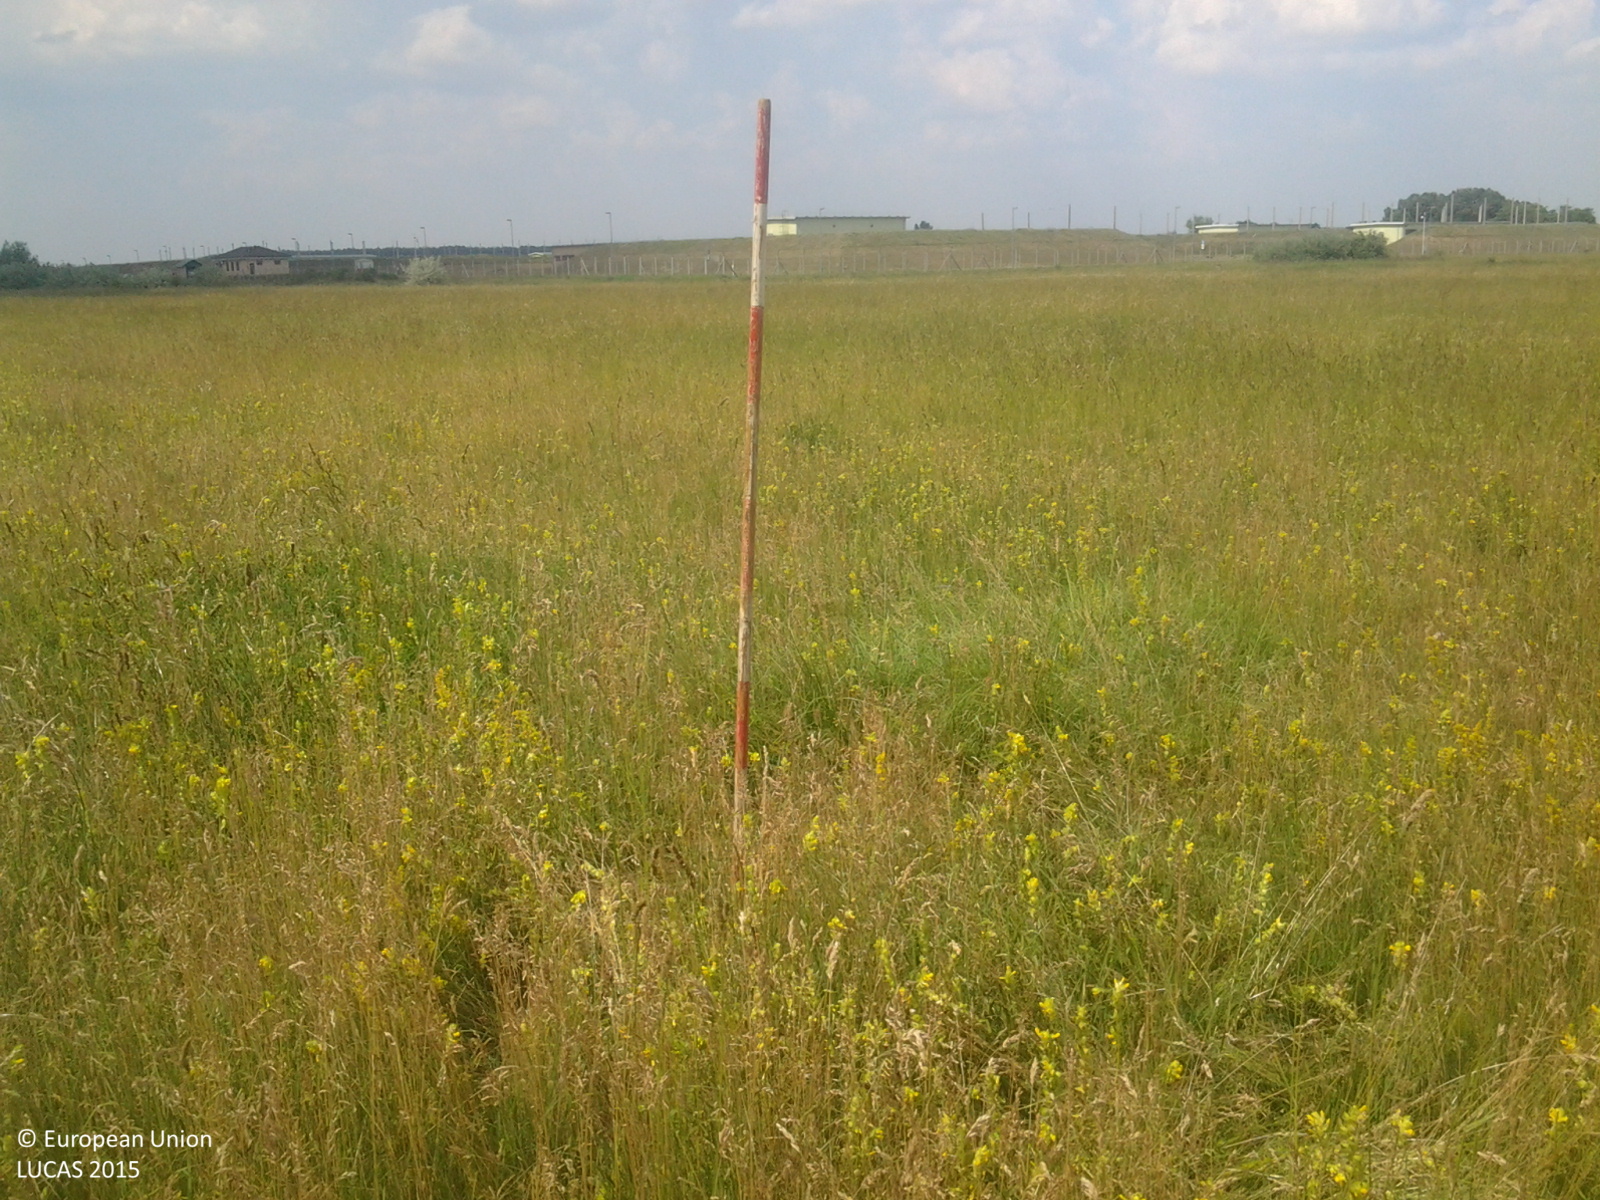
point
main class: Grassland
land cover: Grassland without tree/shrub cover
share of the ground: > 75 %
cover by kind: herbaceous plants 100 %
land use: Agriculture (excluding fallow land and kitchen gardens)
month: June
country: HU
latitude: 46.9177
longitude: 19.7779
